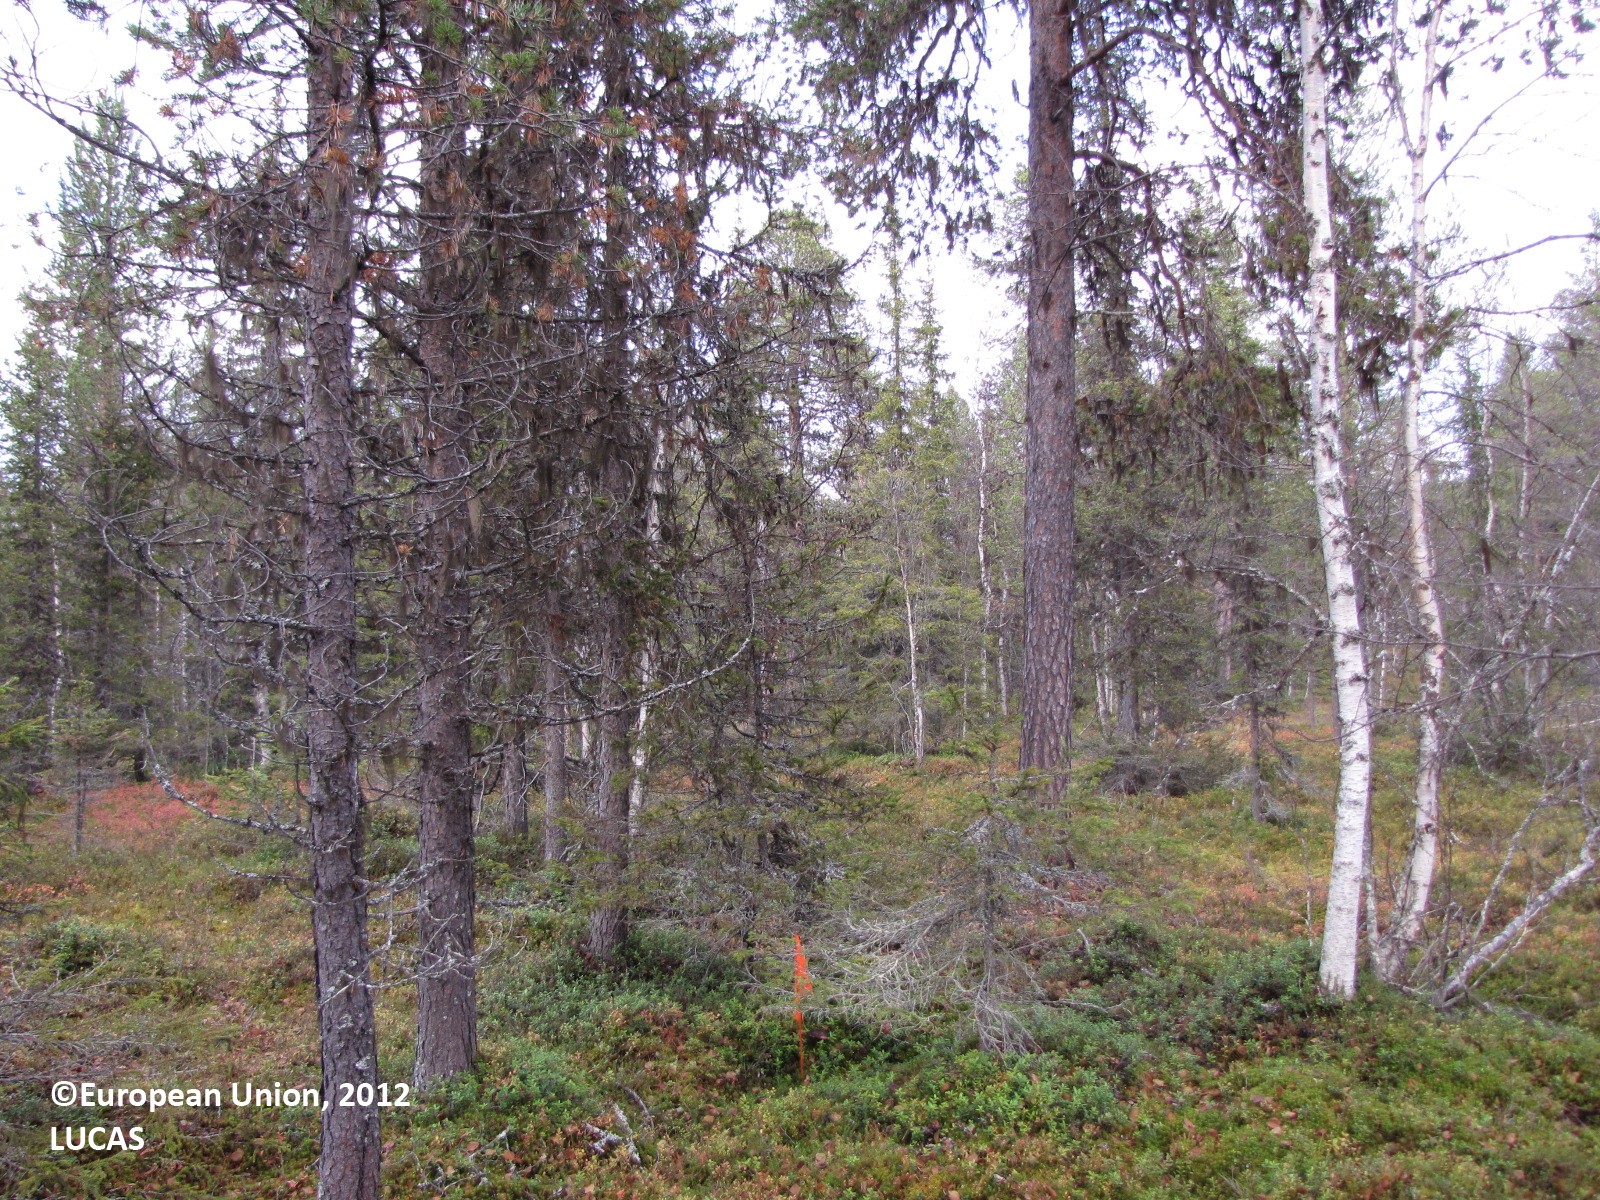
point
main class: Woodland
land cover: Pine dominated mixed woodland
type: boreal forest
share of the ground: 25 - 50 %
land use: Forestry
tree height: > 5 m
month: September
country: FI
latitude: 67.9046
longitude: 24.2430
